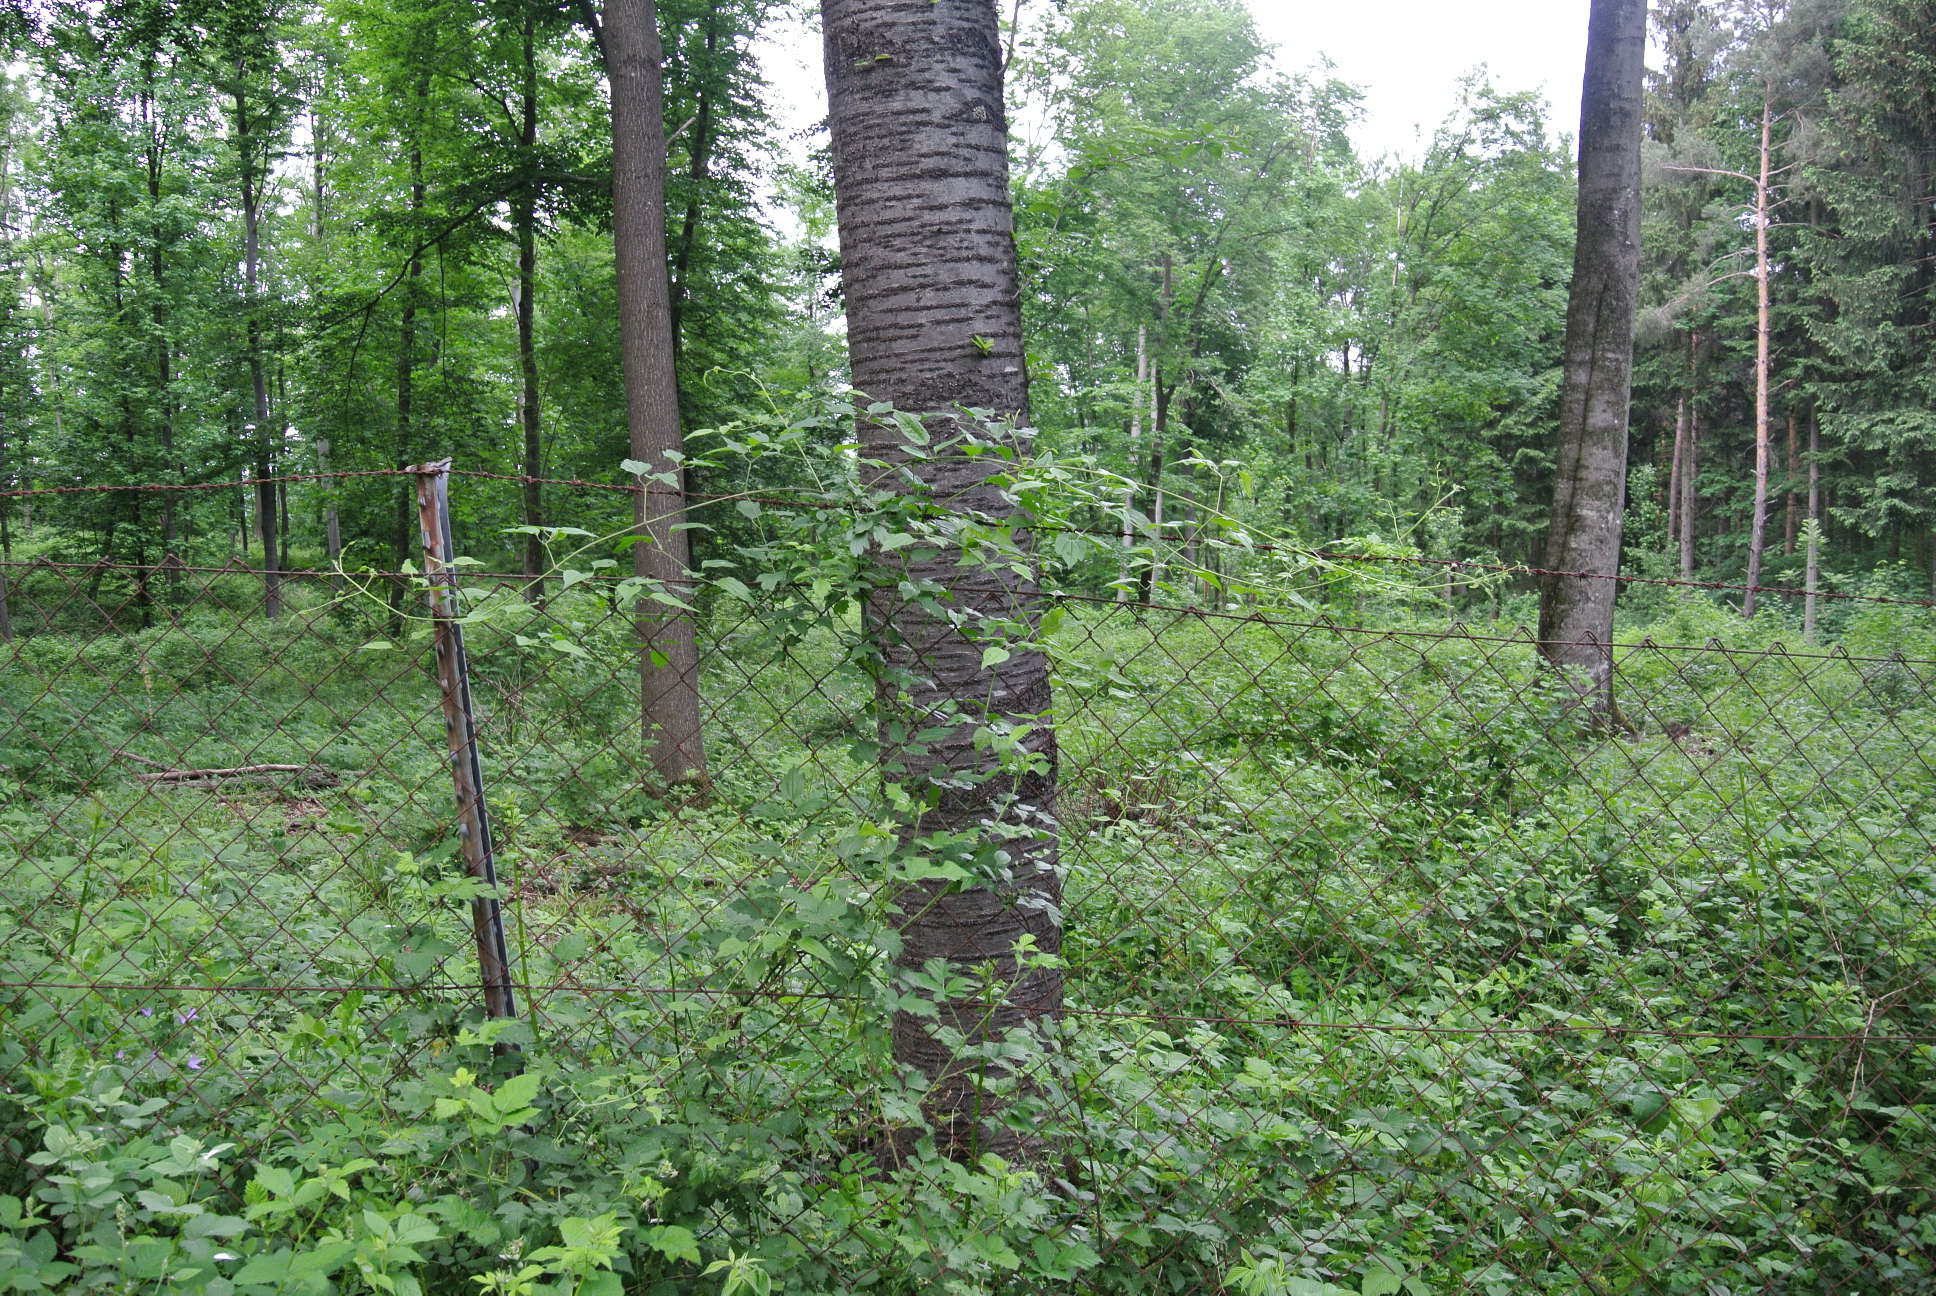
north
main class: Woodland
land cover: Broadleaved woodland
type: beech forest
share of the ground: > 75 %
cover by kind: broadleaved forest trees 80 %, shrubs 10 %, herbaceous plants 10 %
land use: Forestry
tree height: > 5 m
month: June
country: AT
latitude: 48.0527
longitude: 16.1351
